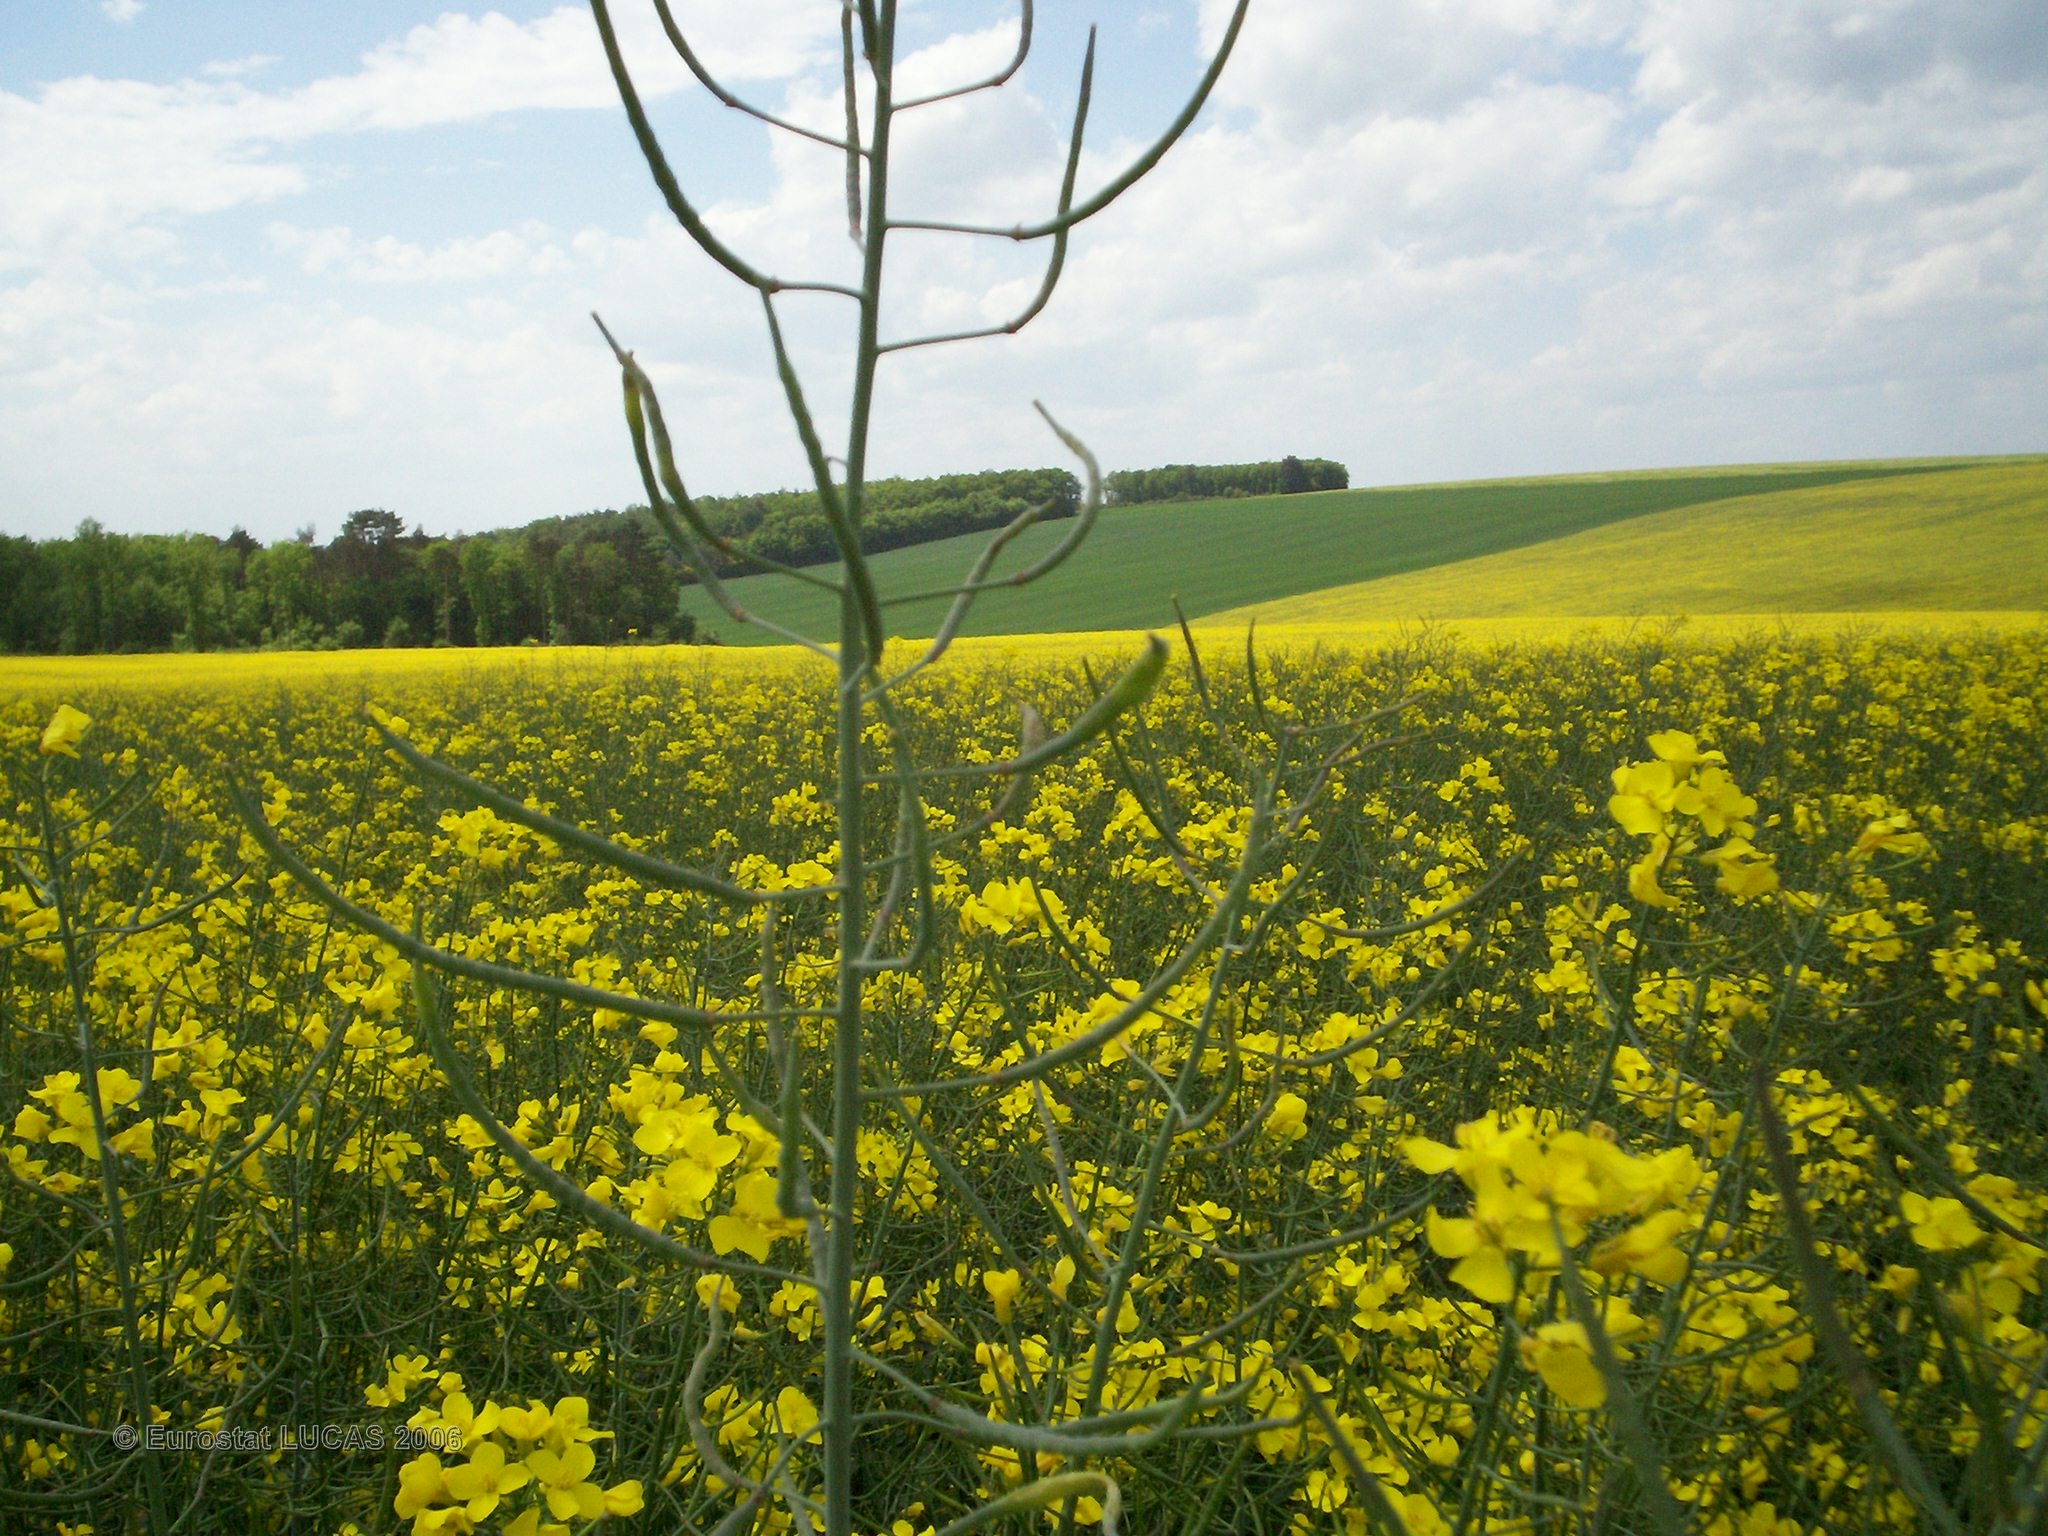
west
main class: Cropland
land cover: Rape and turnip rape
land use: Agriculture (excluding fallow land and kitchen gardens)
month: May
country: FR
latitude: 47.6491
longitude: 4.0735
